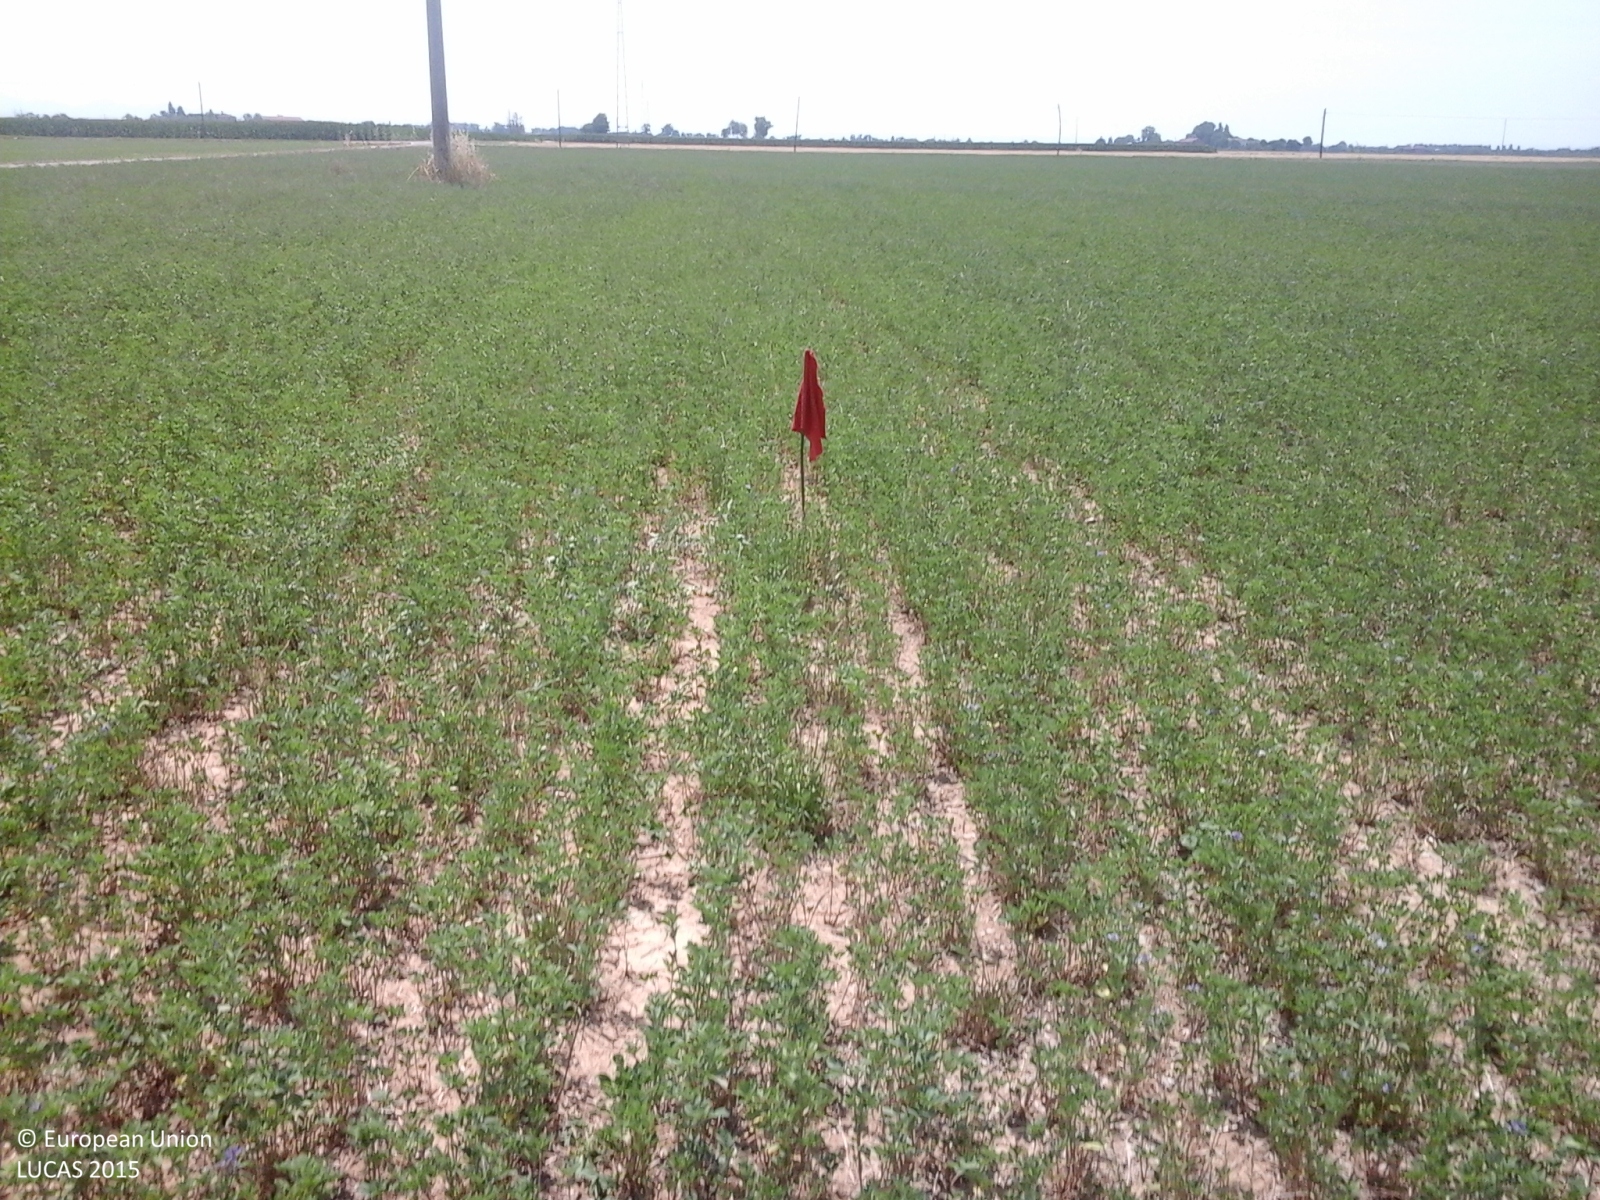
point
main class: Cropland
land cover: Lucerne
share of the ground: > 75 %
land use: Agriculture (excluding fallow land and kitchen gardens)
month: June
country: IT
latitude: 44.9568
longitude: 8.7981
